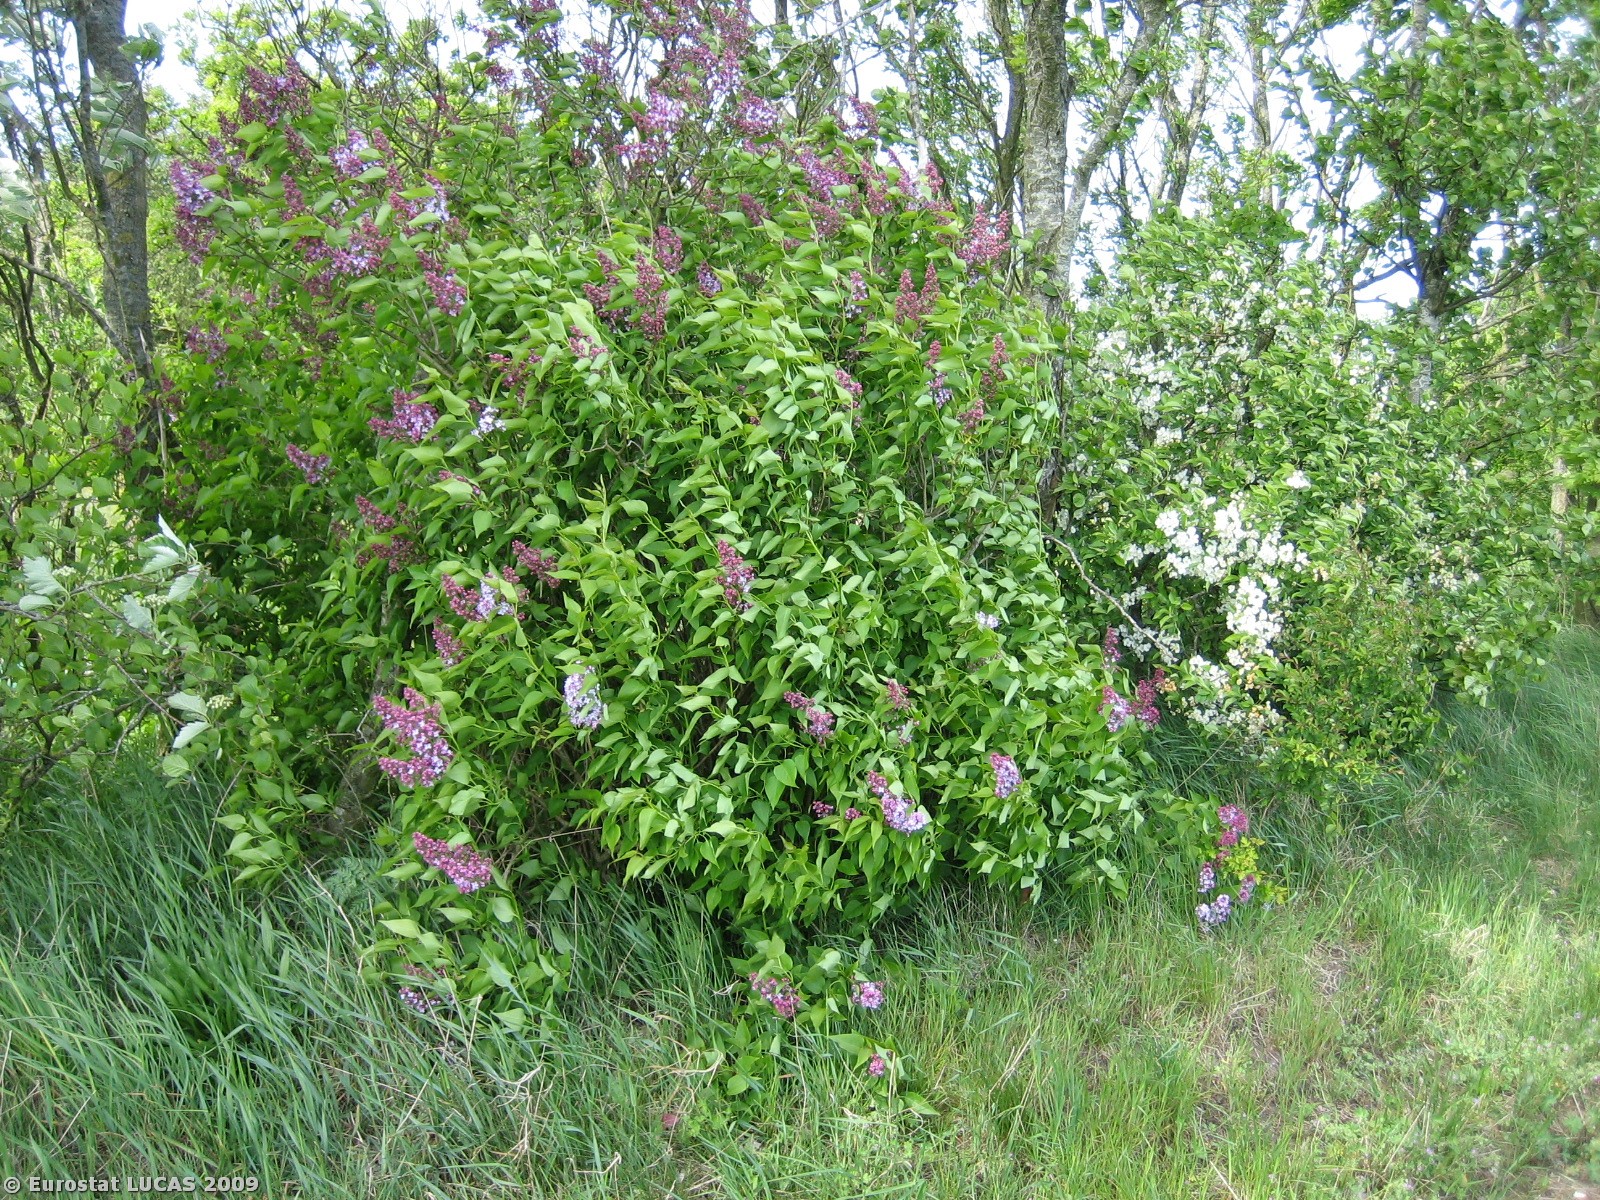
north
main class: Cropland
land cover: Barley
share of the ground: > 75 %
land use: Agriculture (excluding fallow land and kitchen gardens)
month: May
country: DK
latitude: 55.9990
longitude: 8.4783
